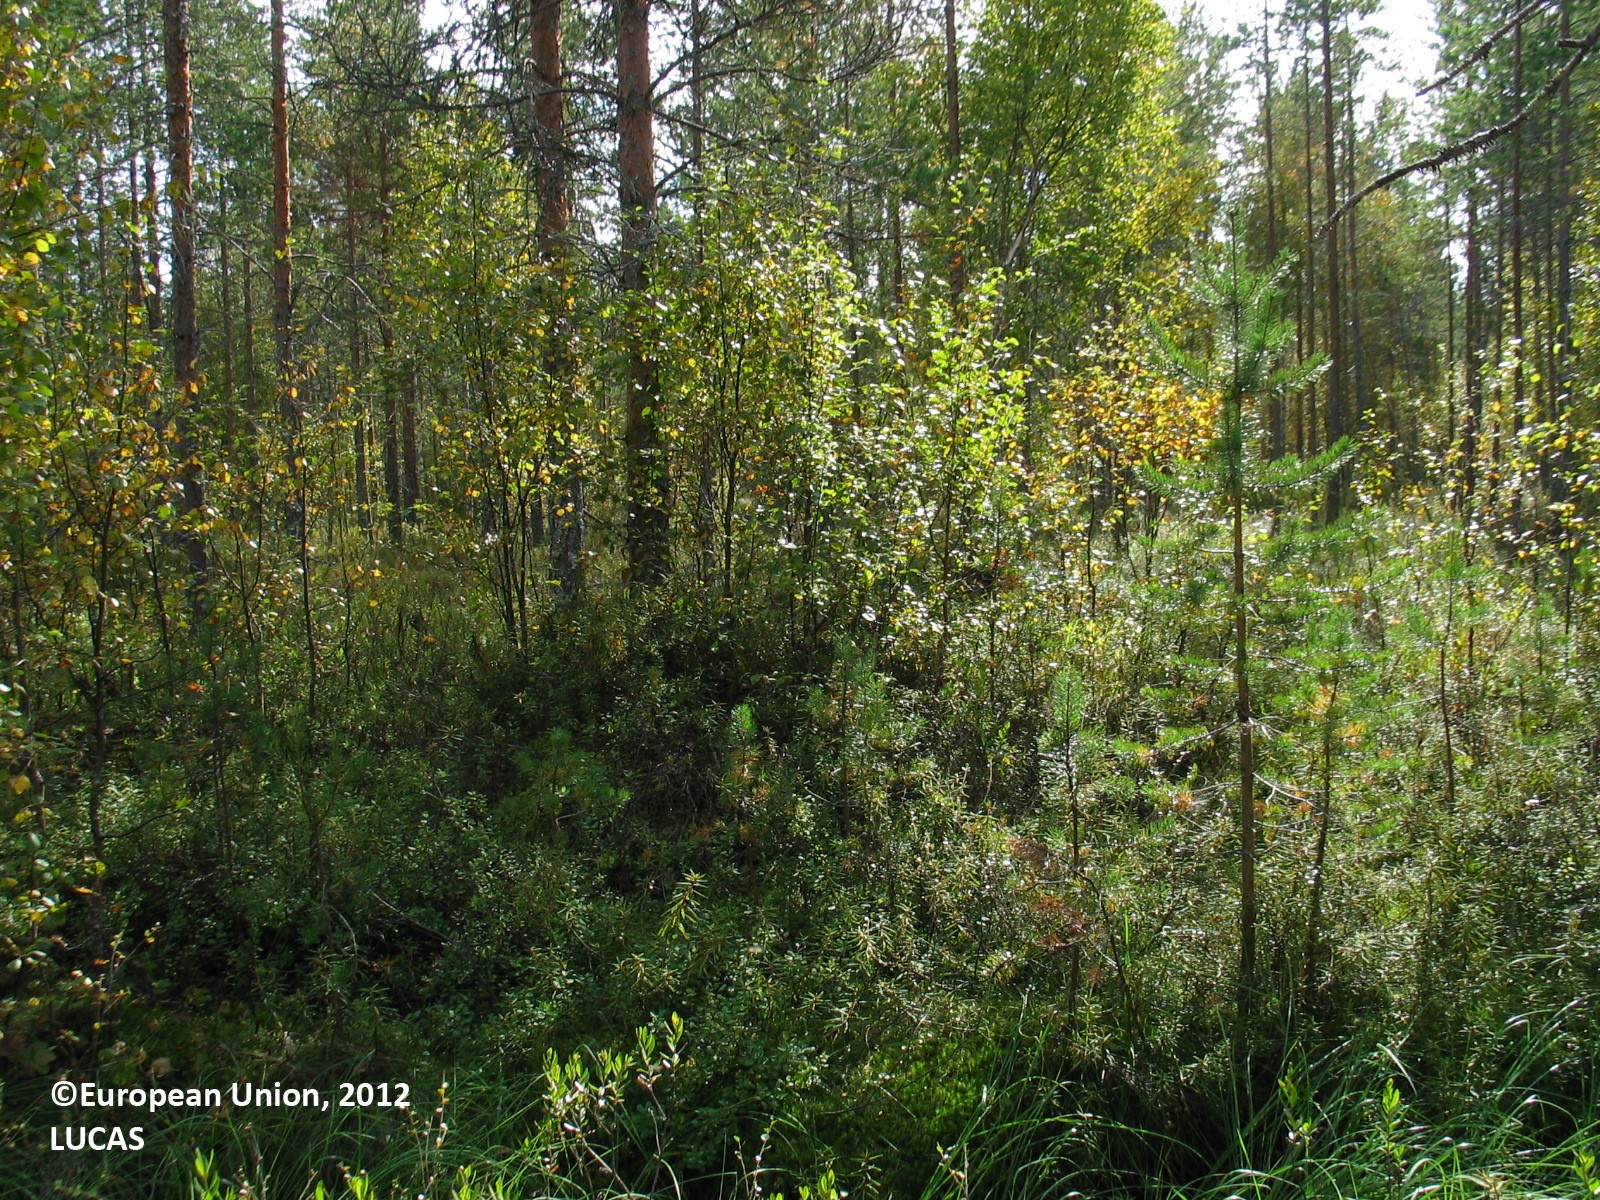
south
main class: Woodland
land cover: Pine dominated coniferous woodland
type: mire and swamp forests
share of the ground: 25 - 50 %
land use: Forestry
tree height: > 5 m
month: August
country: FI
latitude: 65.2394
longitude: 26.4300
